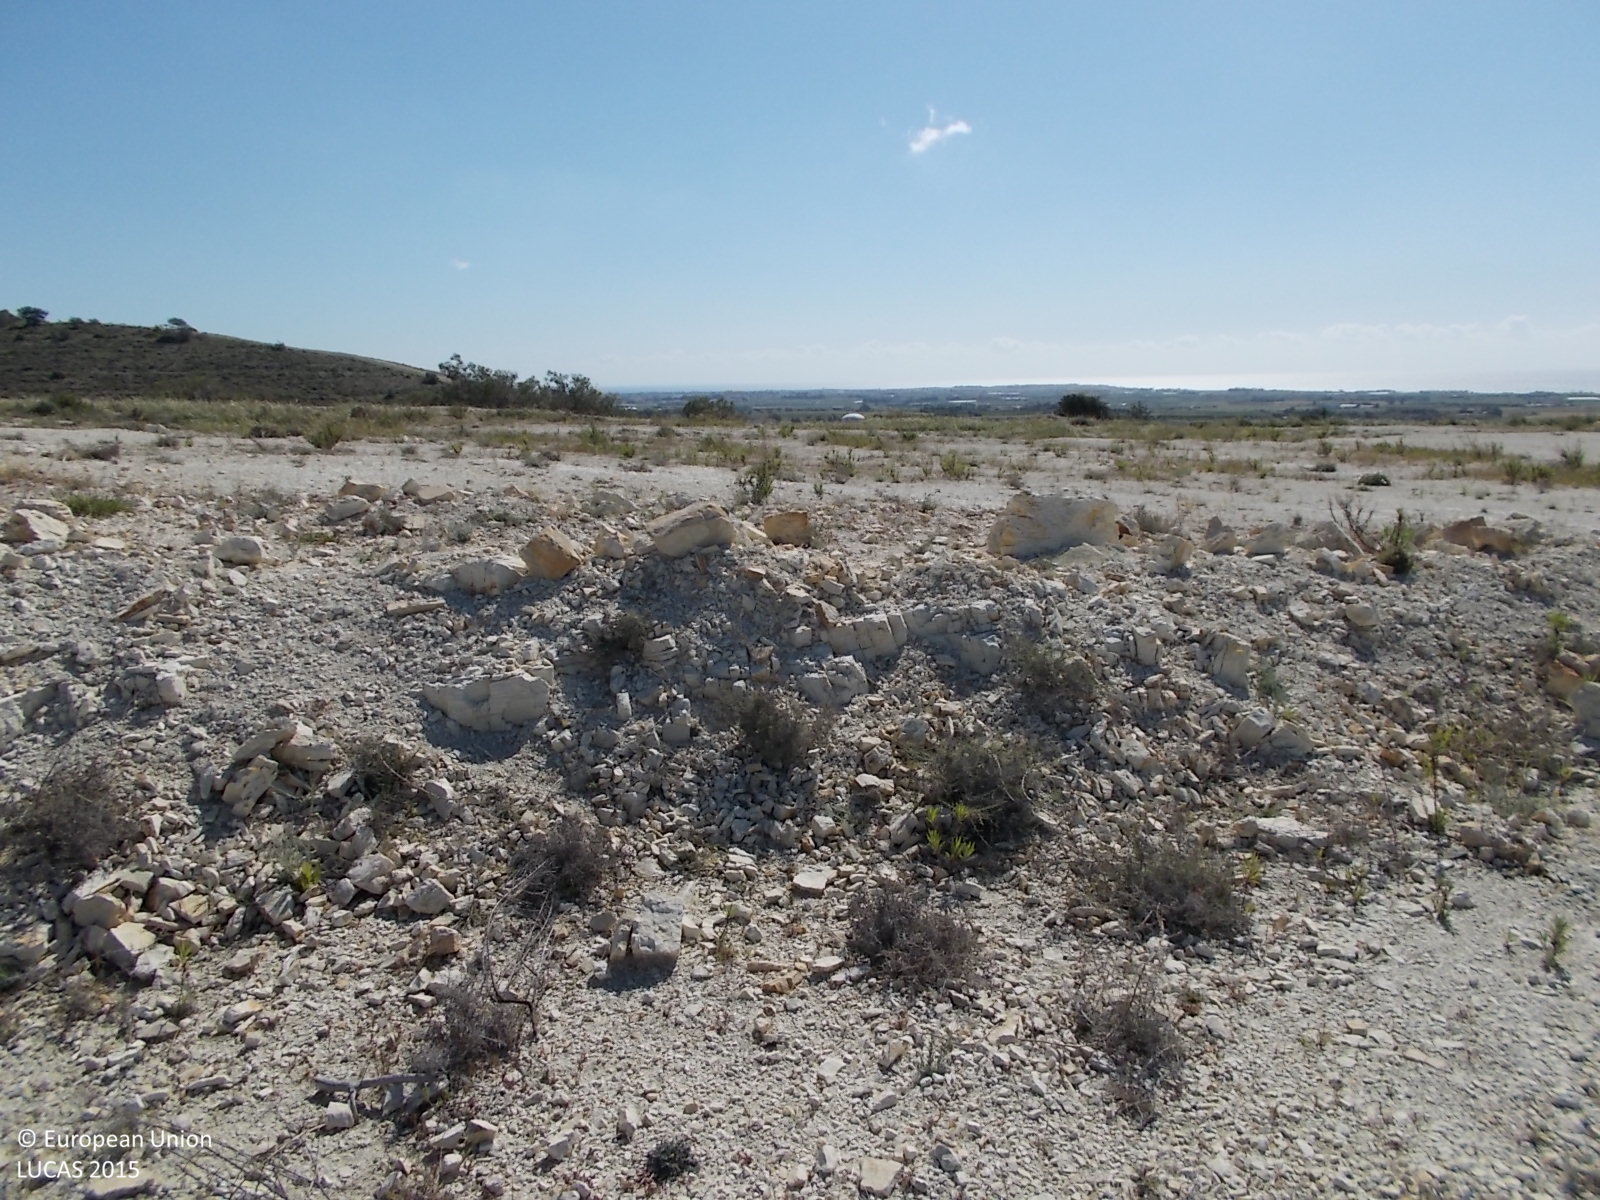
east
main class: Shrubland
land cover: Shrubland without tree cover
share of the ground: 10 - 25 %
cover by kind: unconsolidated bare surface 85 %, shrubs 10 %, herbaceous plants 5 %
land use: Abandoned areas
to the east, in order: Shrubland without tree cover; Shrubland with sparse tree cover; Shrubland without tree cover; Pine dominated coniferous woodland; Shrubland without tree cover; Barley; Shrubland with sparse tree cover; Barley; Shrubland without tree cover; Pine dominated coniferous woodland
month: April
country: CY
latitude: 34.8479
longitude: 33.5171
